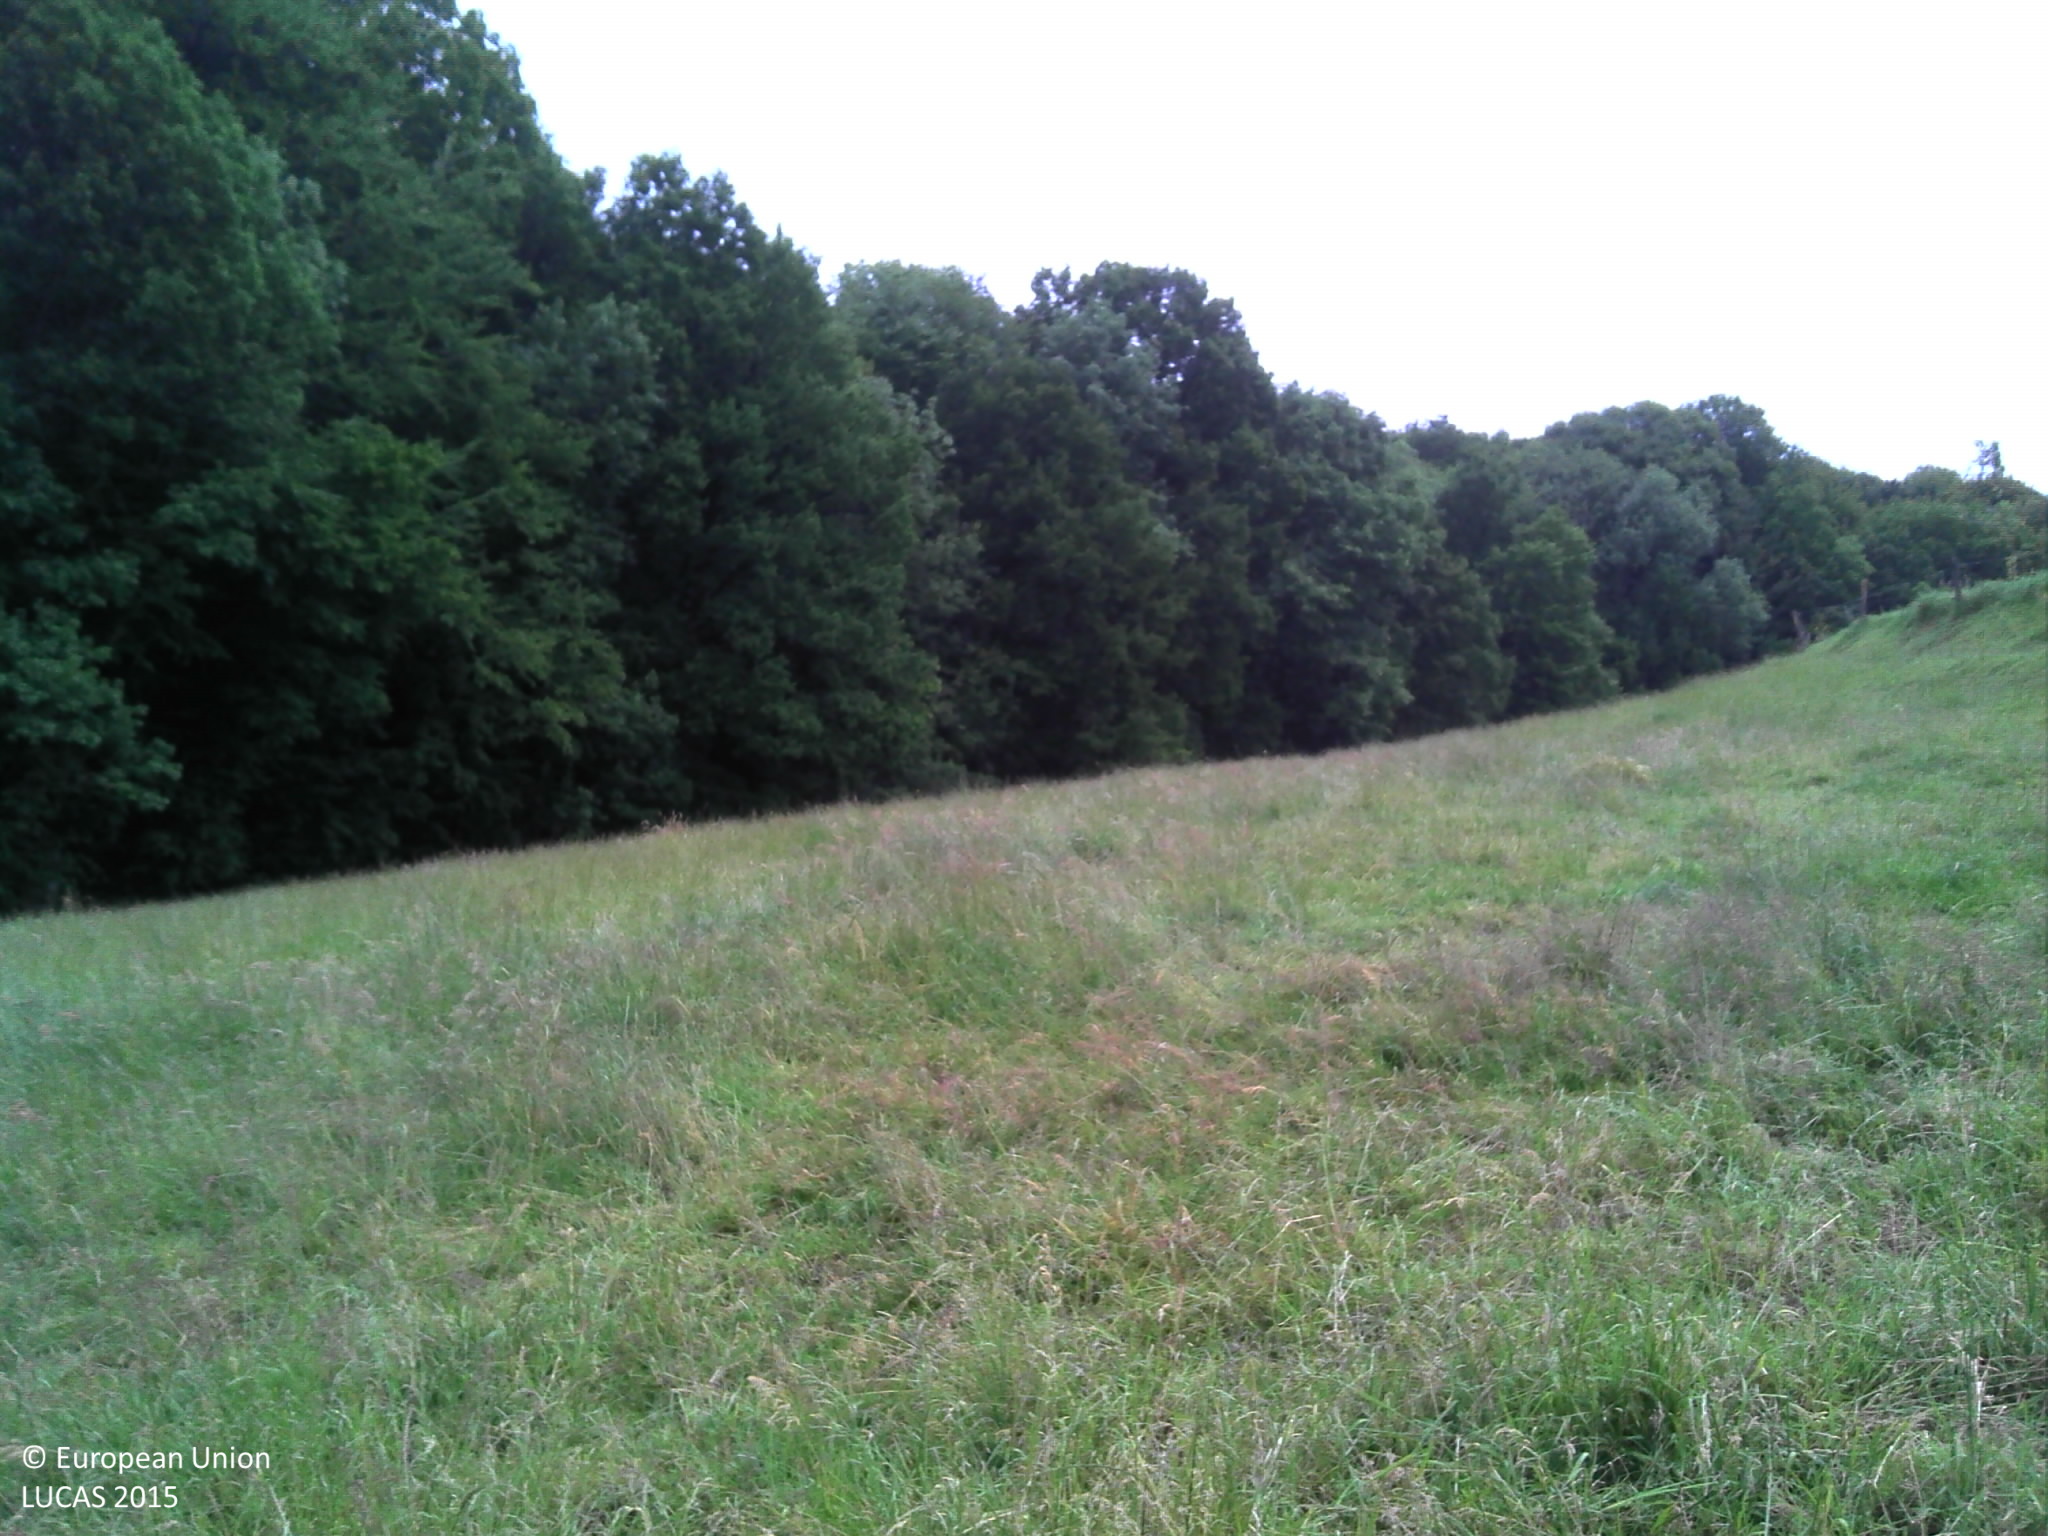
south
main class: Grassland
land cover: Grassland without tree/shrub cover
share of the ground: > 75 %
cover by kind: herbaceous plants 100 %
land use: Agriculture (excluding fallow land and kitchen gardens)
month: June
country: BE
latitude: 50.7651
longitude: 3.6553
